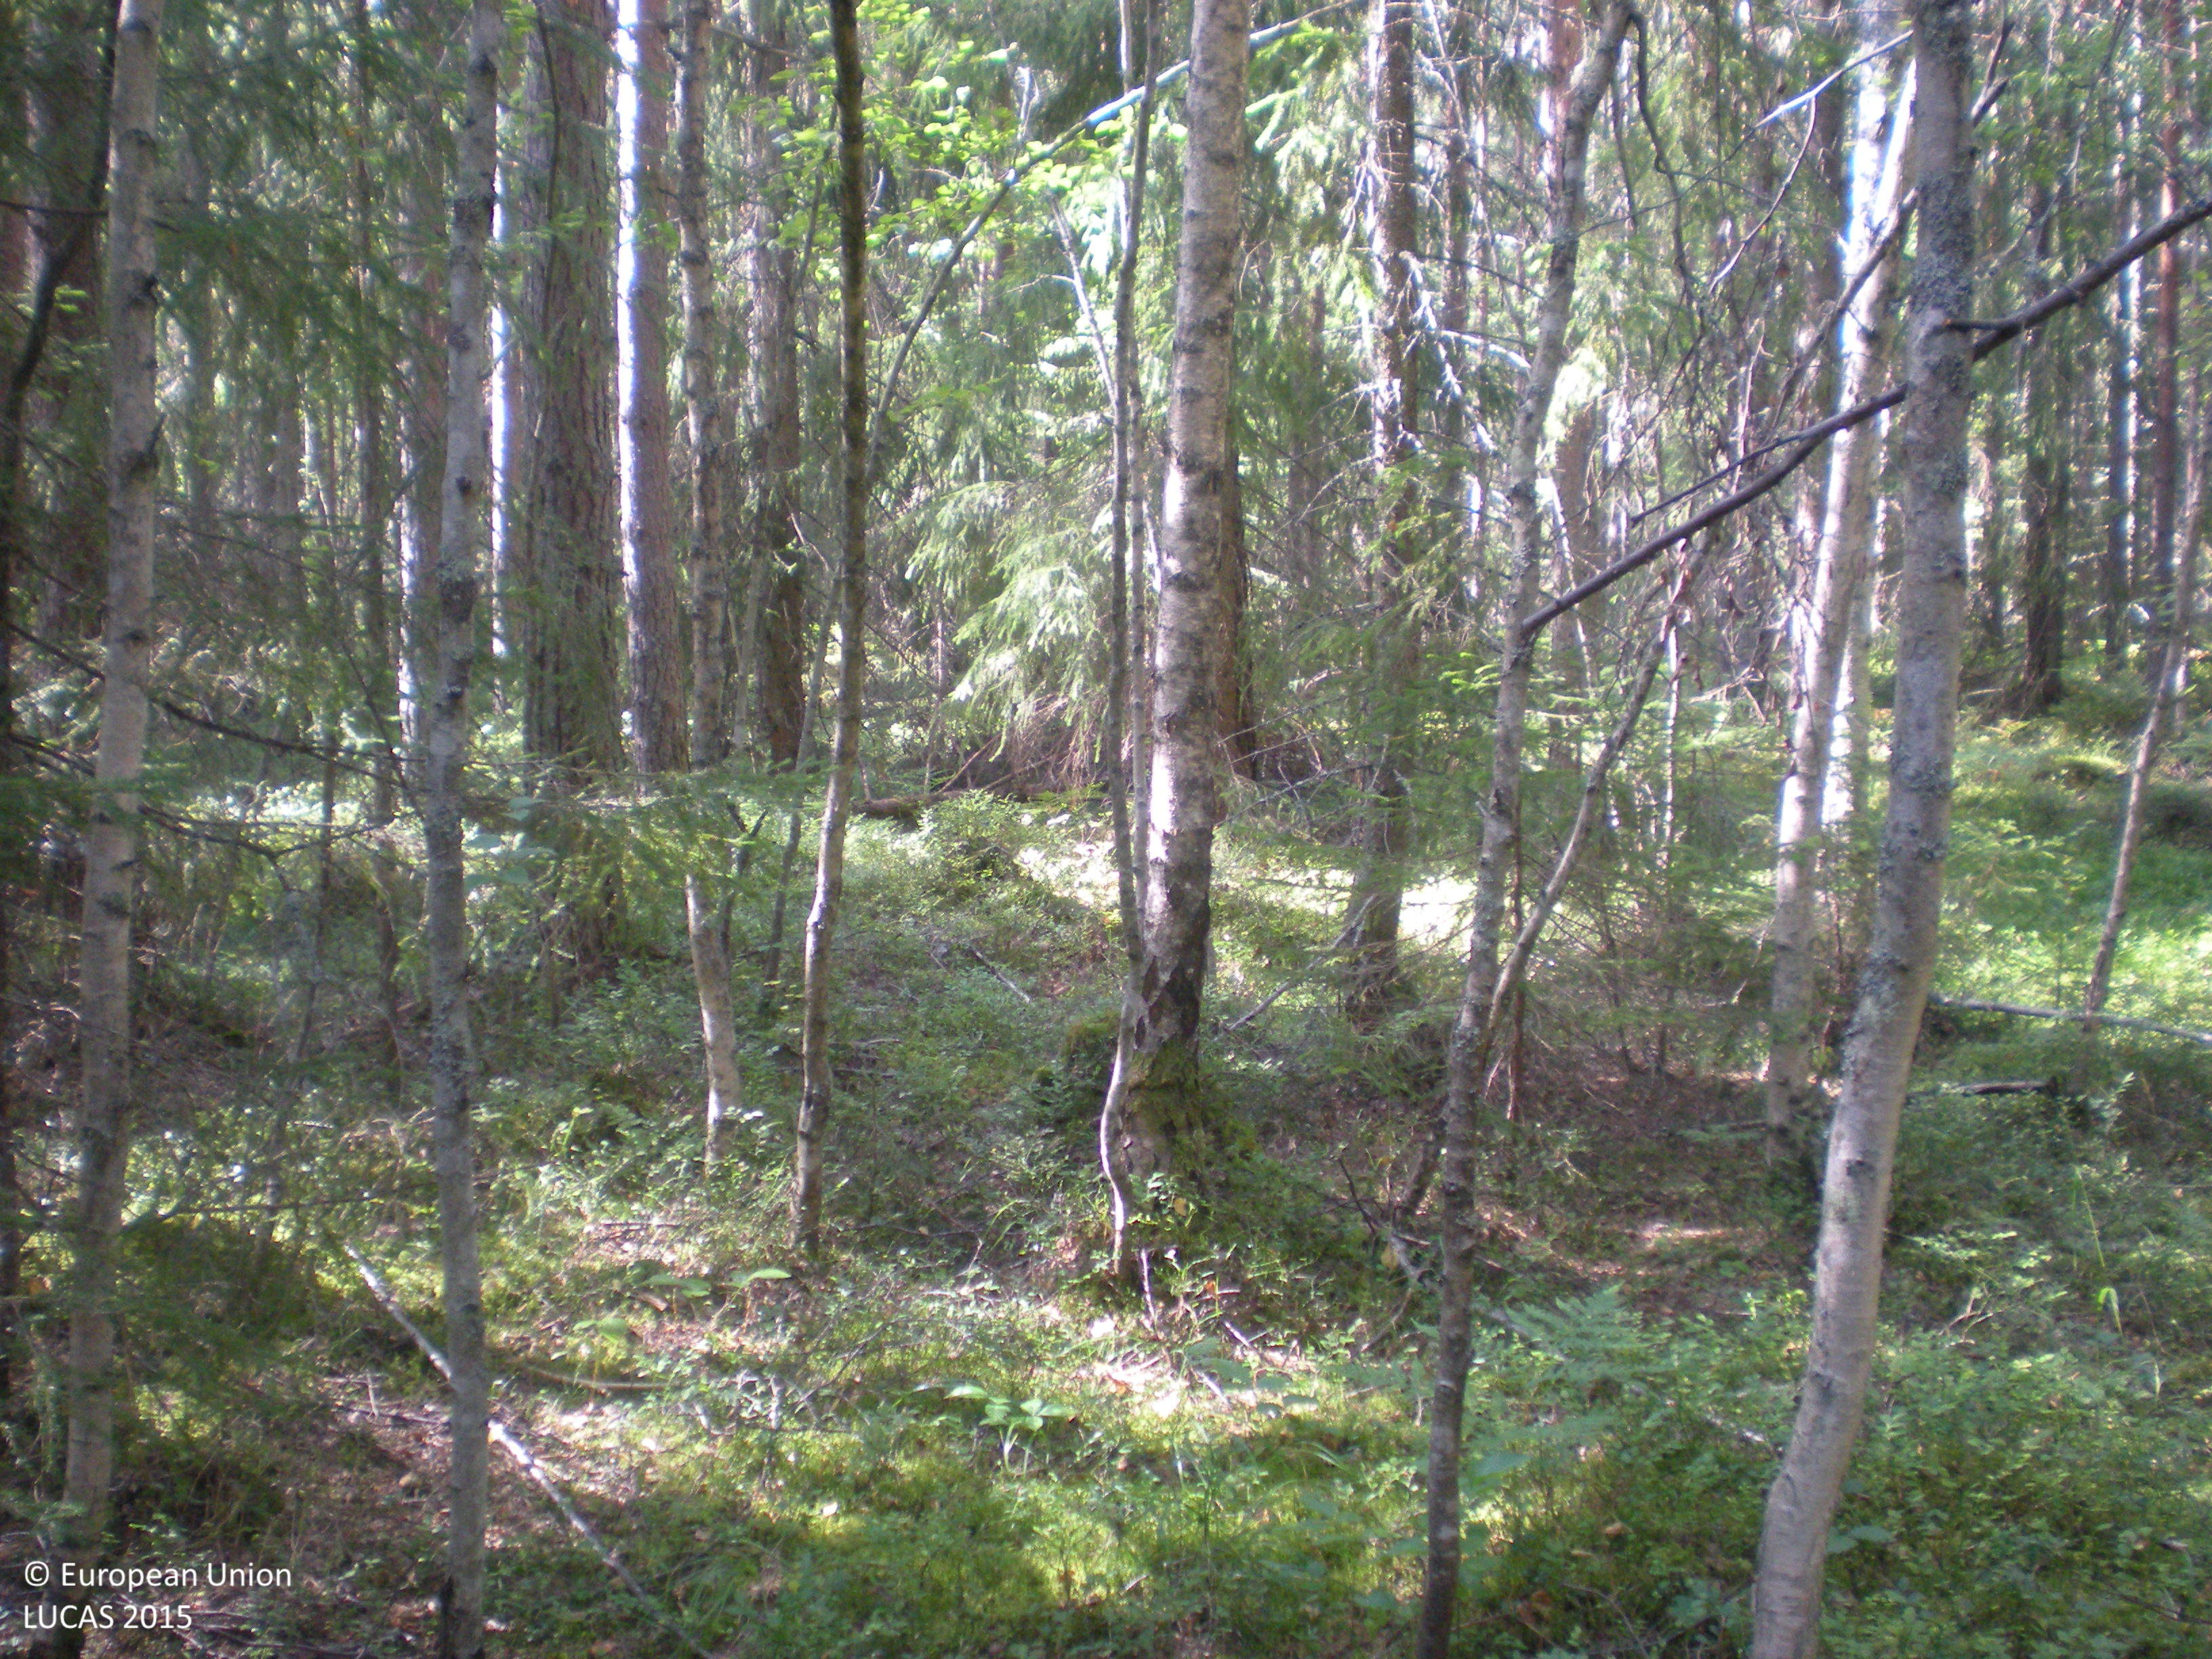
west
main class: Woodland
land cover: Other mixed woodland
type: boreal forest
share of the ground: > 75 %
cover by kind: coniferous forest trees 55 %, broadleaved forest trees 20 %, shrubs 15 %, lichens and mosses 10 %
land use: Forestry
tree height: > 5 m
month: August
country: SE
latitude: 60.5219
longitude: 16.8207
